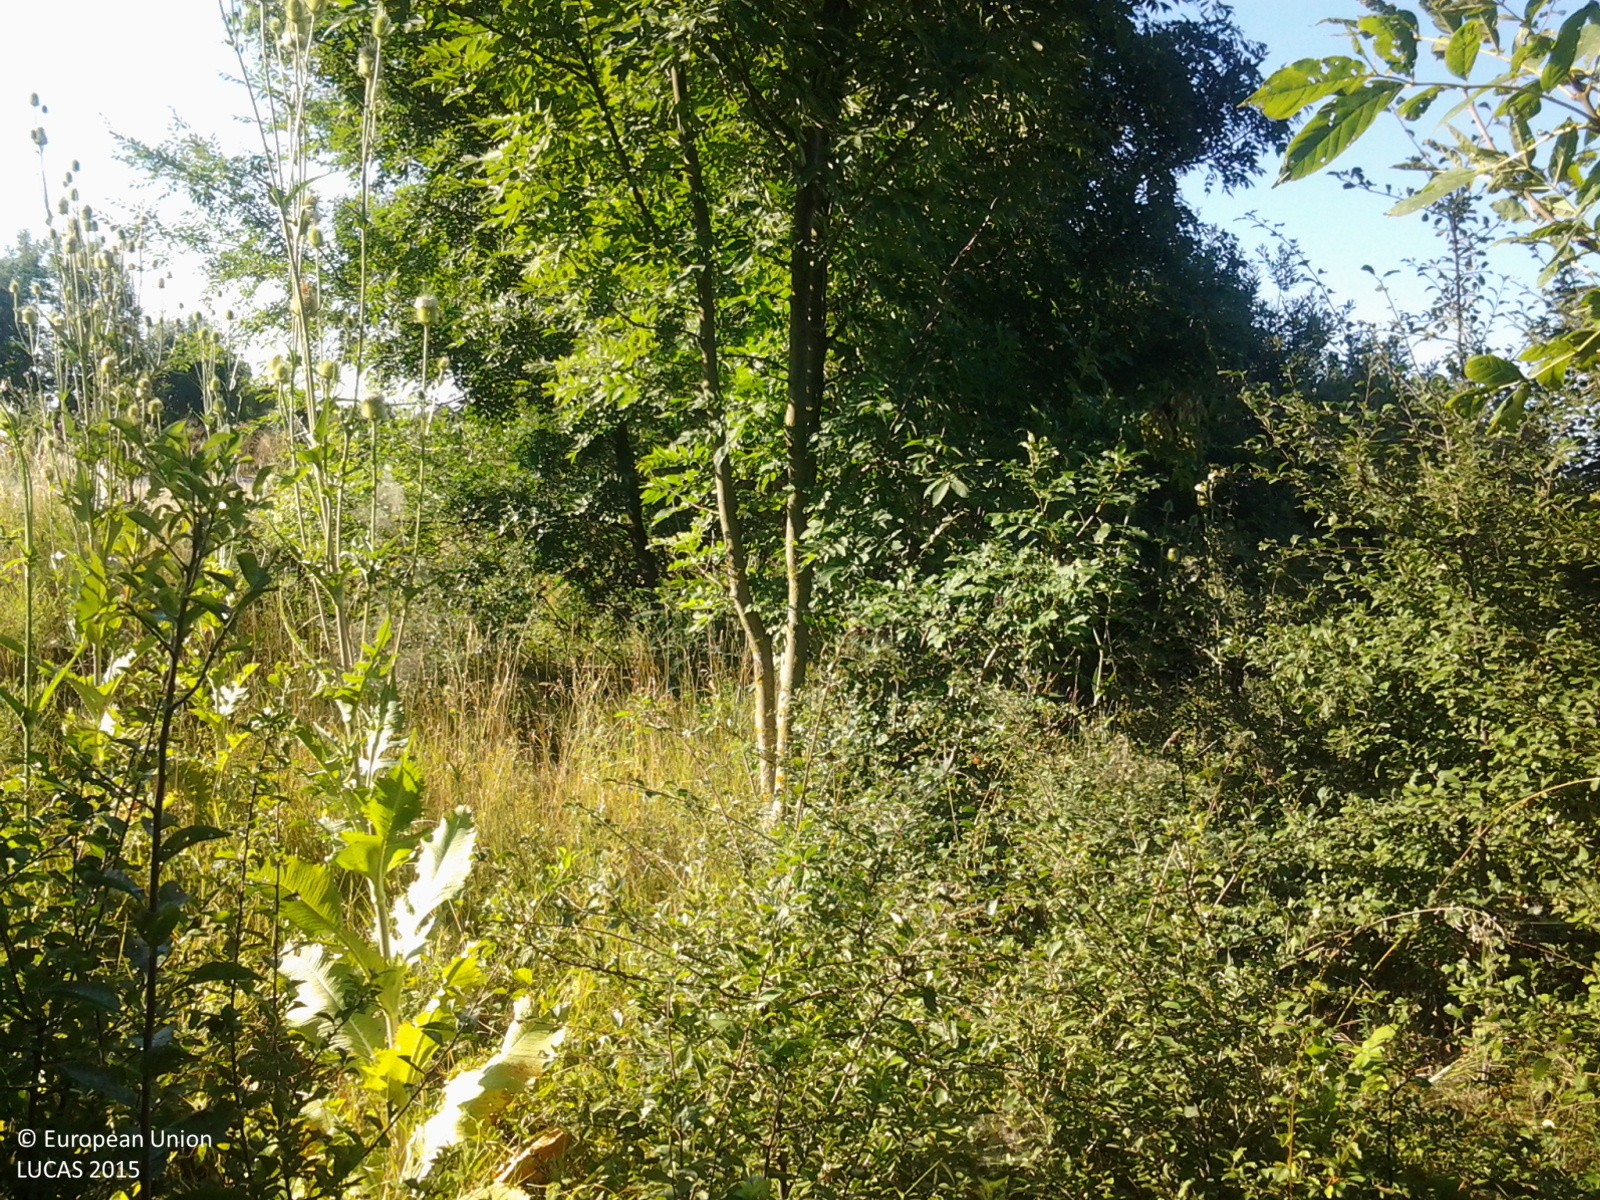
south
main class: Woodland
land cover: Broadleaved woodland
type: mesophytic deciduous forest
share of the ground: > 75 %
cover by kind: broadleaved forest trees 80 %, shrubs 10 %, herbaceous plants 10 %
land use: Forestry
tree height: > 5 m
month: July
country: HU
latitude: 46.7931
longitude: 21.2372
